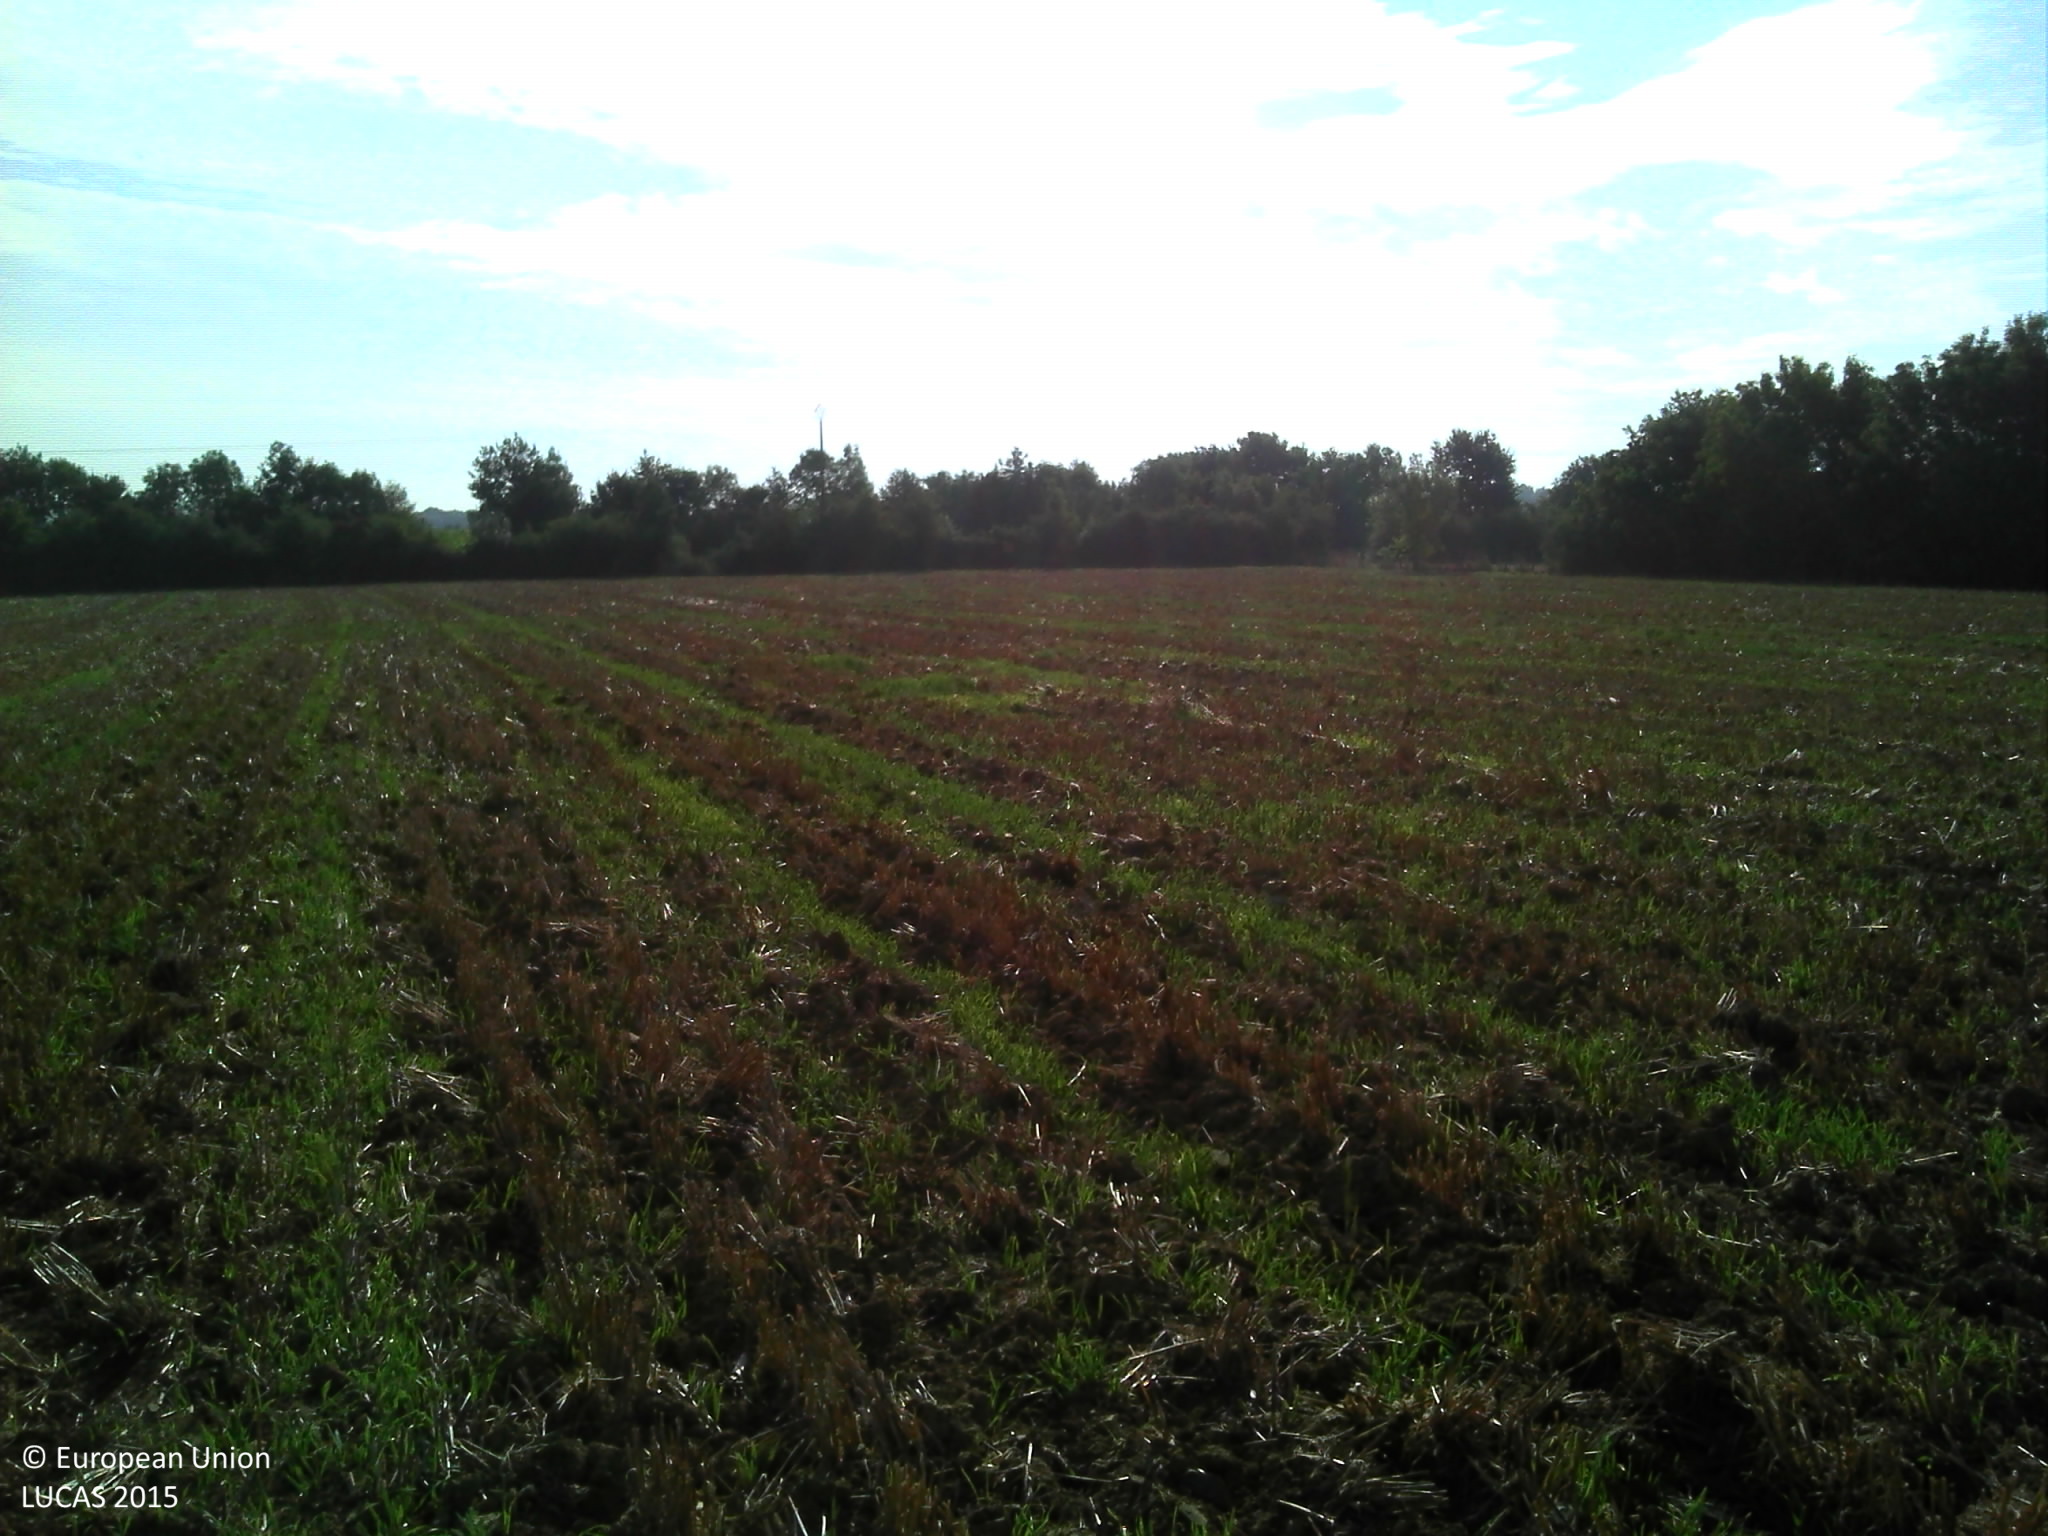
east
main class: Cropland
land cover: Barley
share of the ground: < 10 %
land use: Agriculture (excluding fallow land and kitchen gardens)
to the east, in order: Barley; Fences; Shrubland with sparse tree cover; Electric lines; Ditches and canals; Grass margins; Paved roads, cycling and walking lanes; Grass margins; Ditches and canals; Broadleaved woodland; Maize
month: August
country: FR
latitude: 47.4203
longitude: -1.8307
